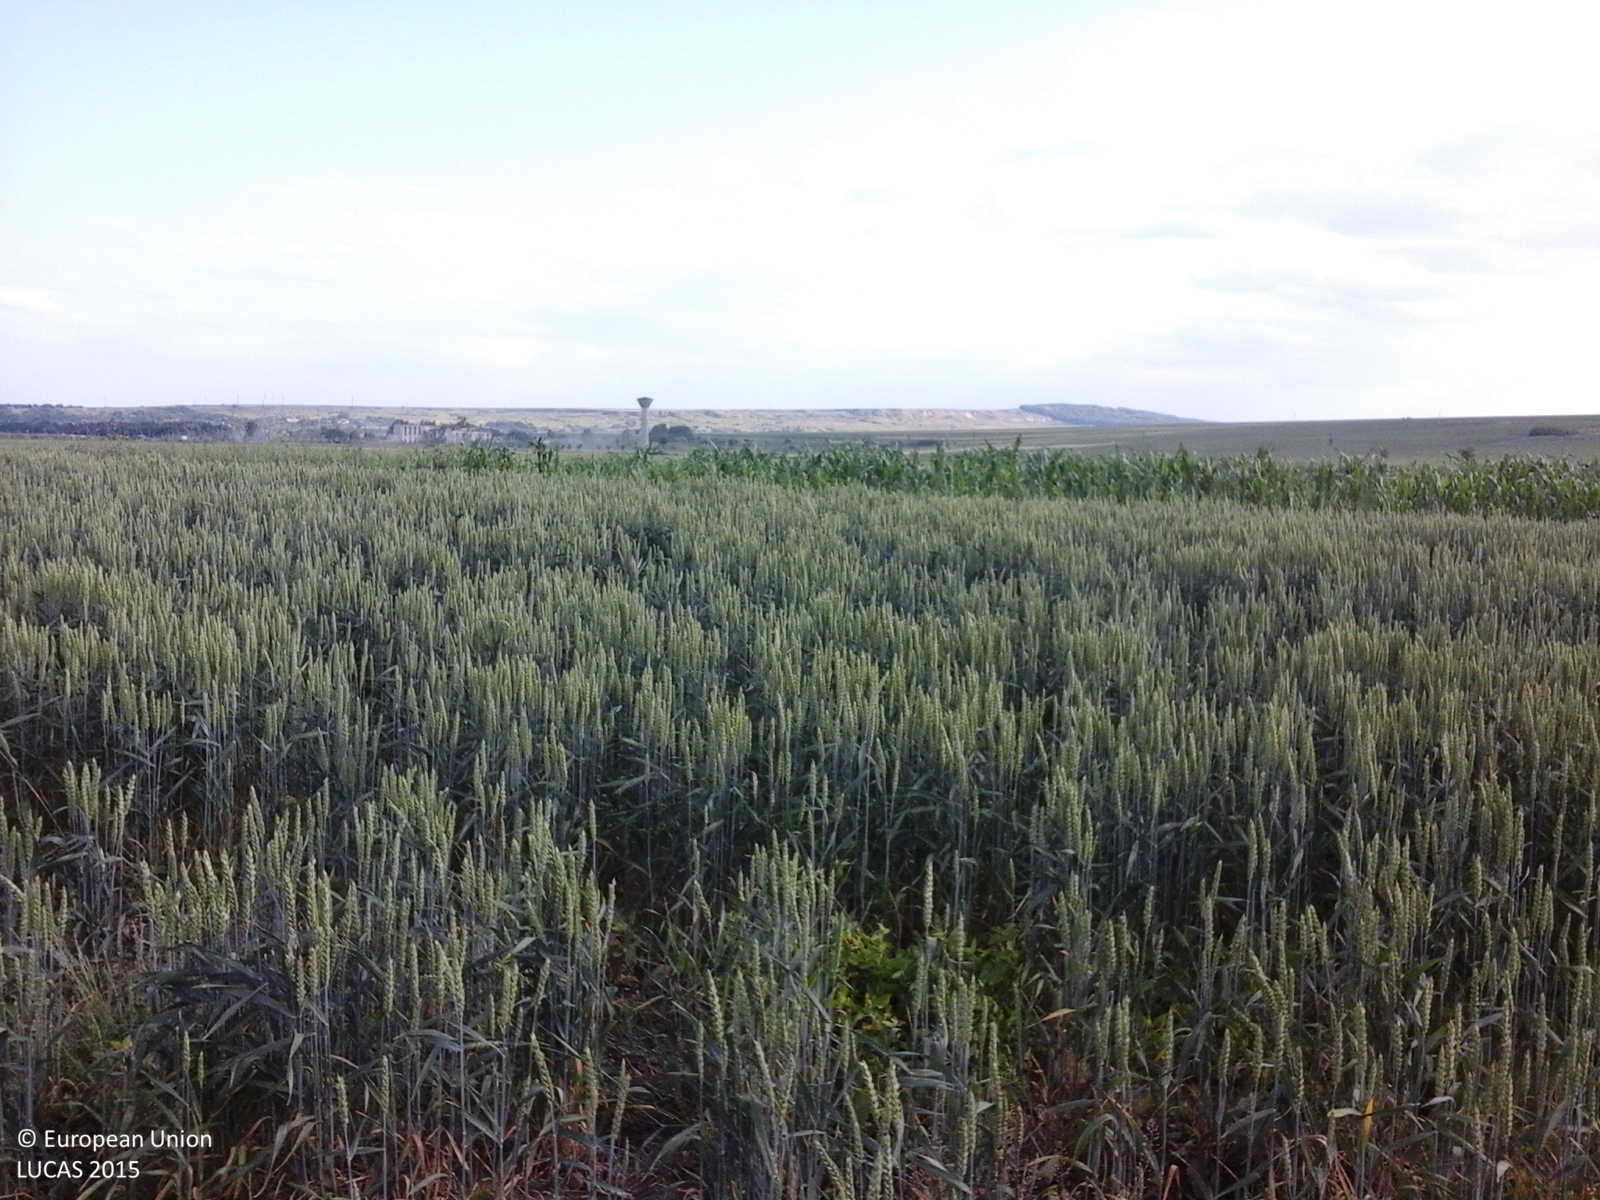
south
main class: Grassland
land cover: Grassland without tree/shrub cover
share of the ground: > 75 %
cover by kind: herbaceous plants 100 %
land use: Agriculture (excluding fallow land and kitchen gardens)
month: June
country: RO
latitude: 47.7804
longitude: 26.3558
